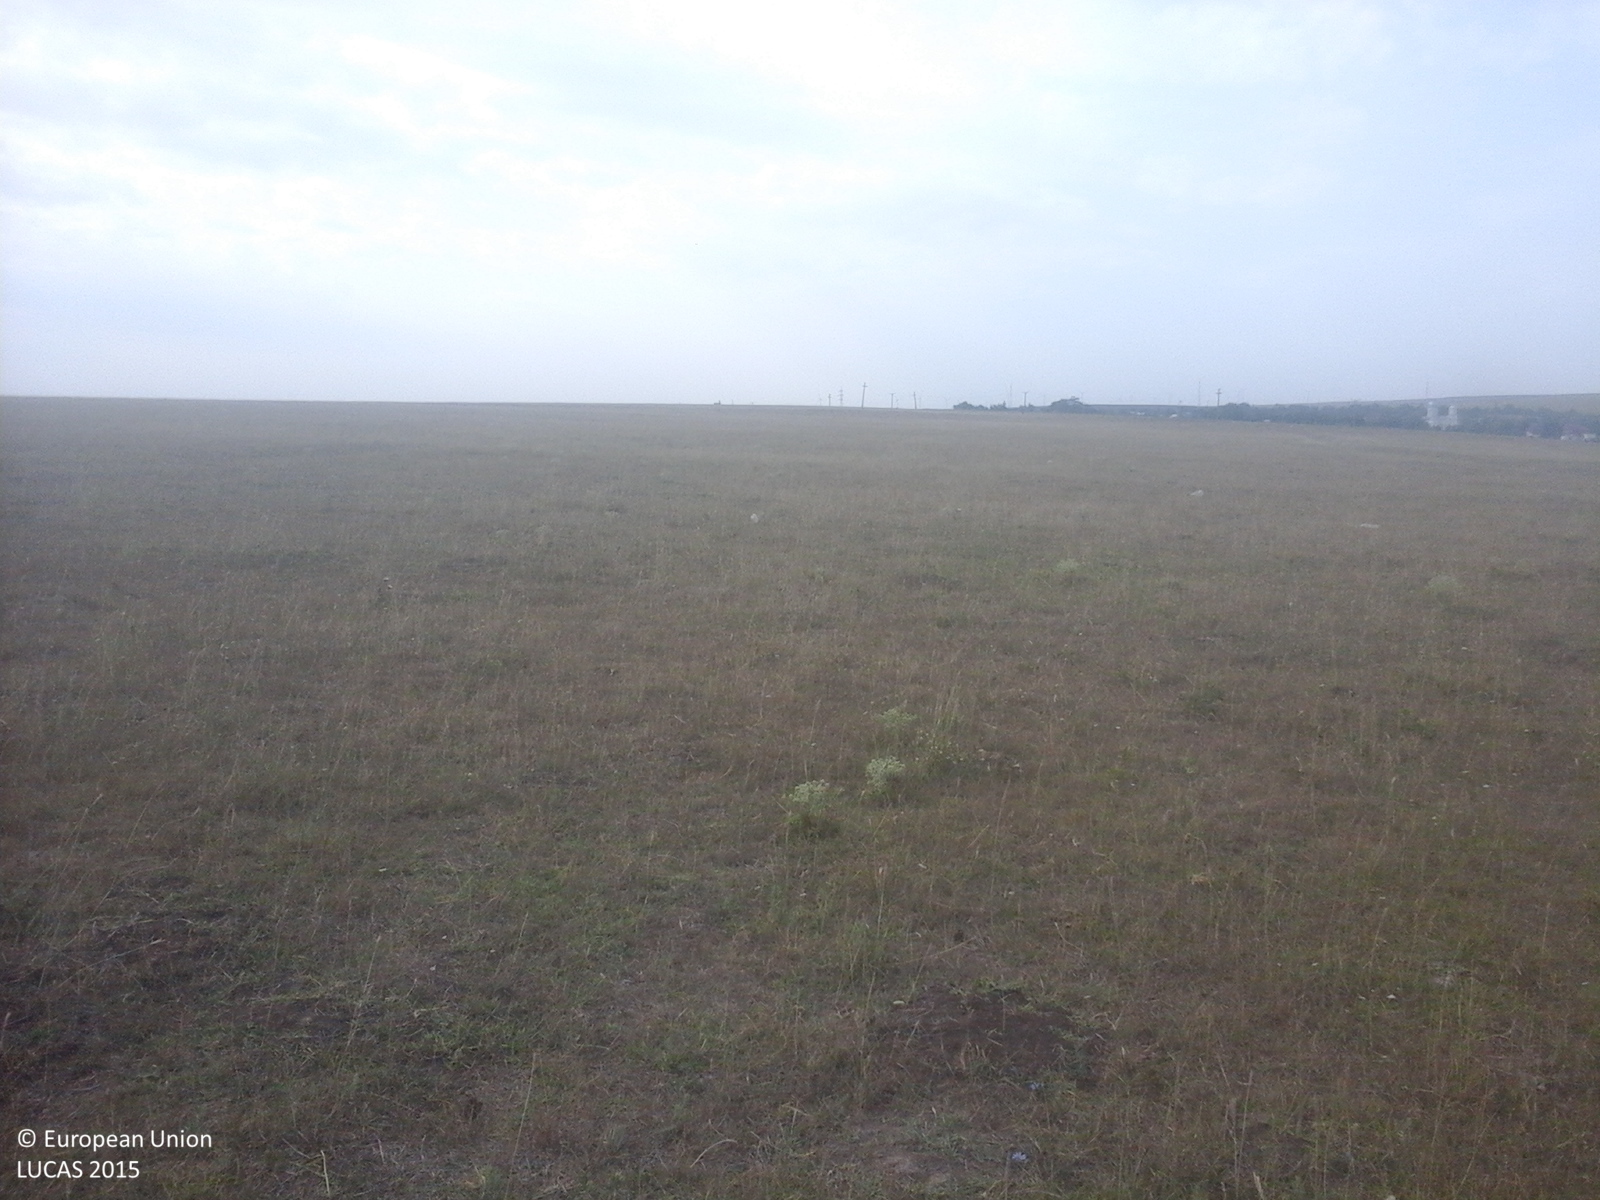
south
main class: Grassland
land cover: Grassland without tree/shrub cover
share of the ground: > 75 %
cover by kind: herbaceous plants 100 %
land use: Agriculture (excluding fallow land and kitchen gardens)
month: August
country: RO
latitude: 43.9710
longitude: 28.1426
